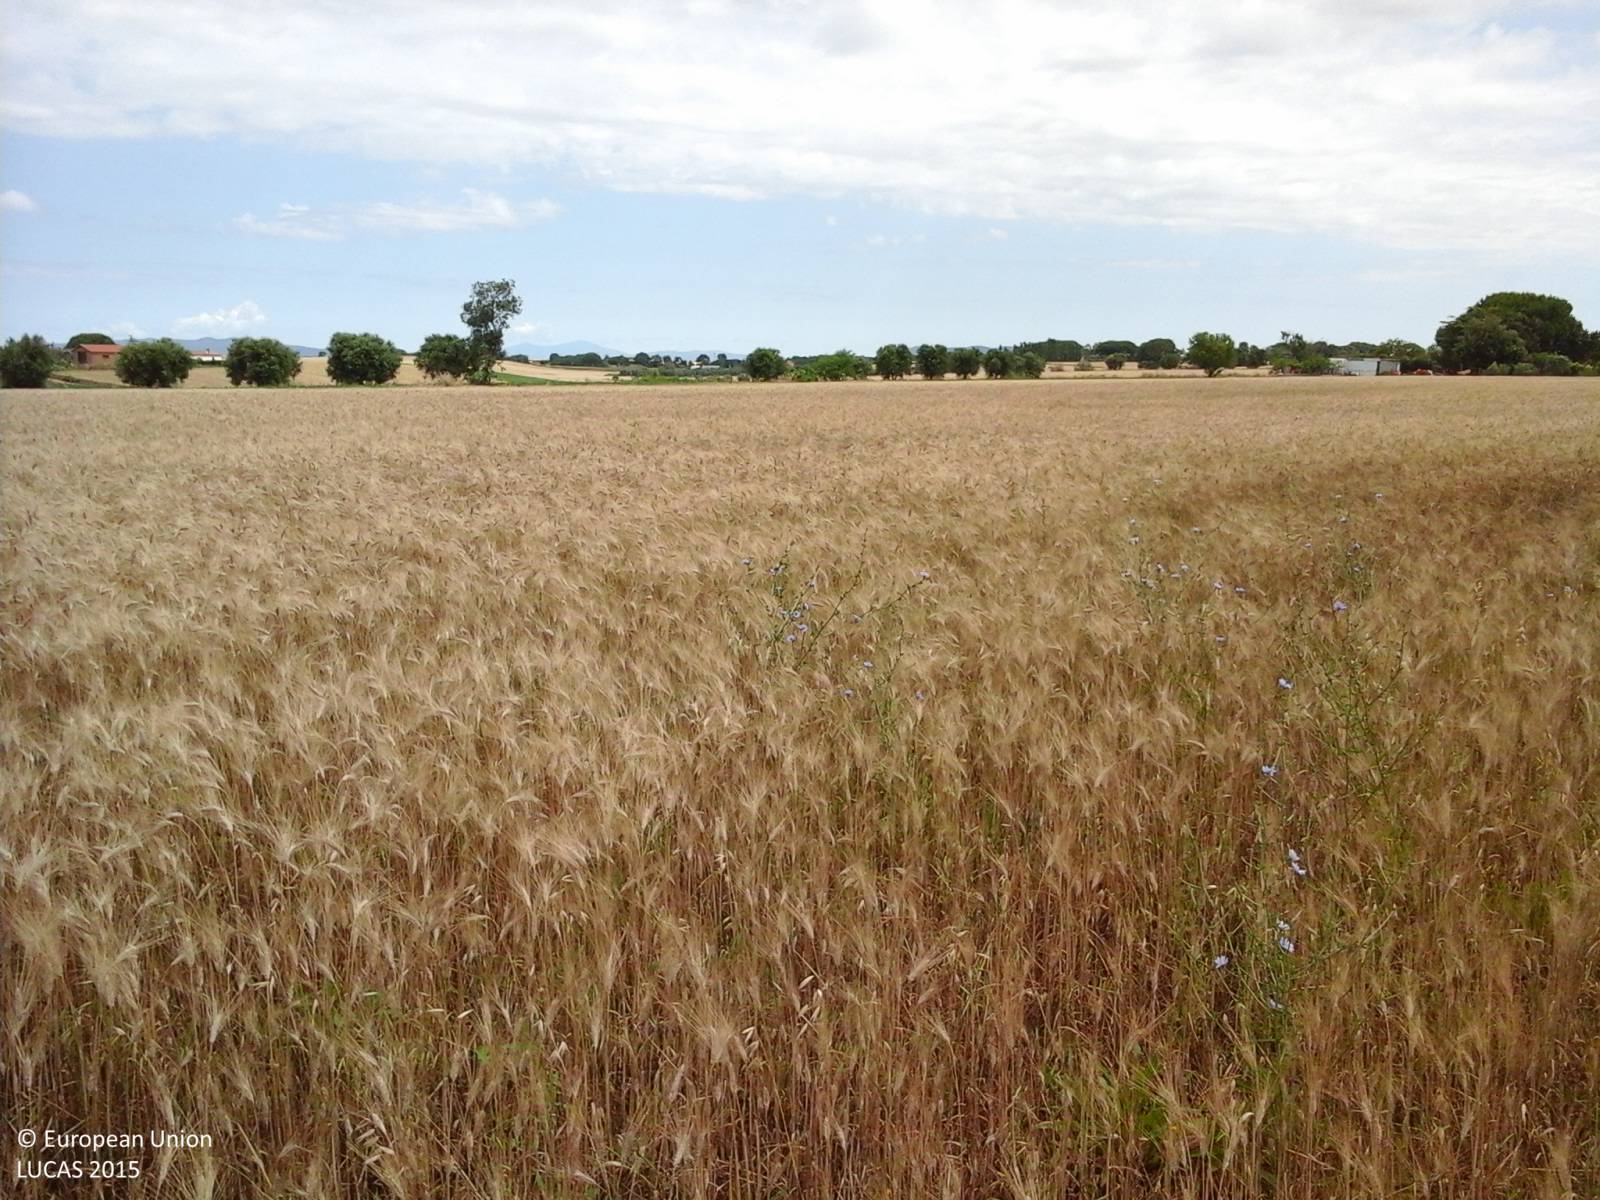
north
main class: Cropland
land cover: Durum wheat
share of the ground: > 75 %
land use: Agriculture (excluding fallow land and kitchen gardens)
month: June
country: IT
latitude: 42.2972
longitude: 11.6558
